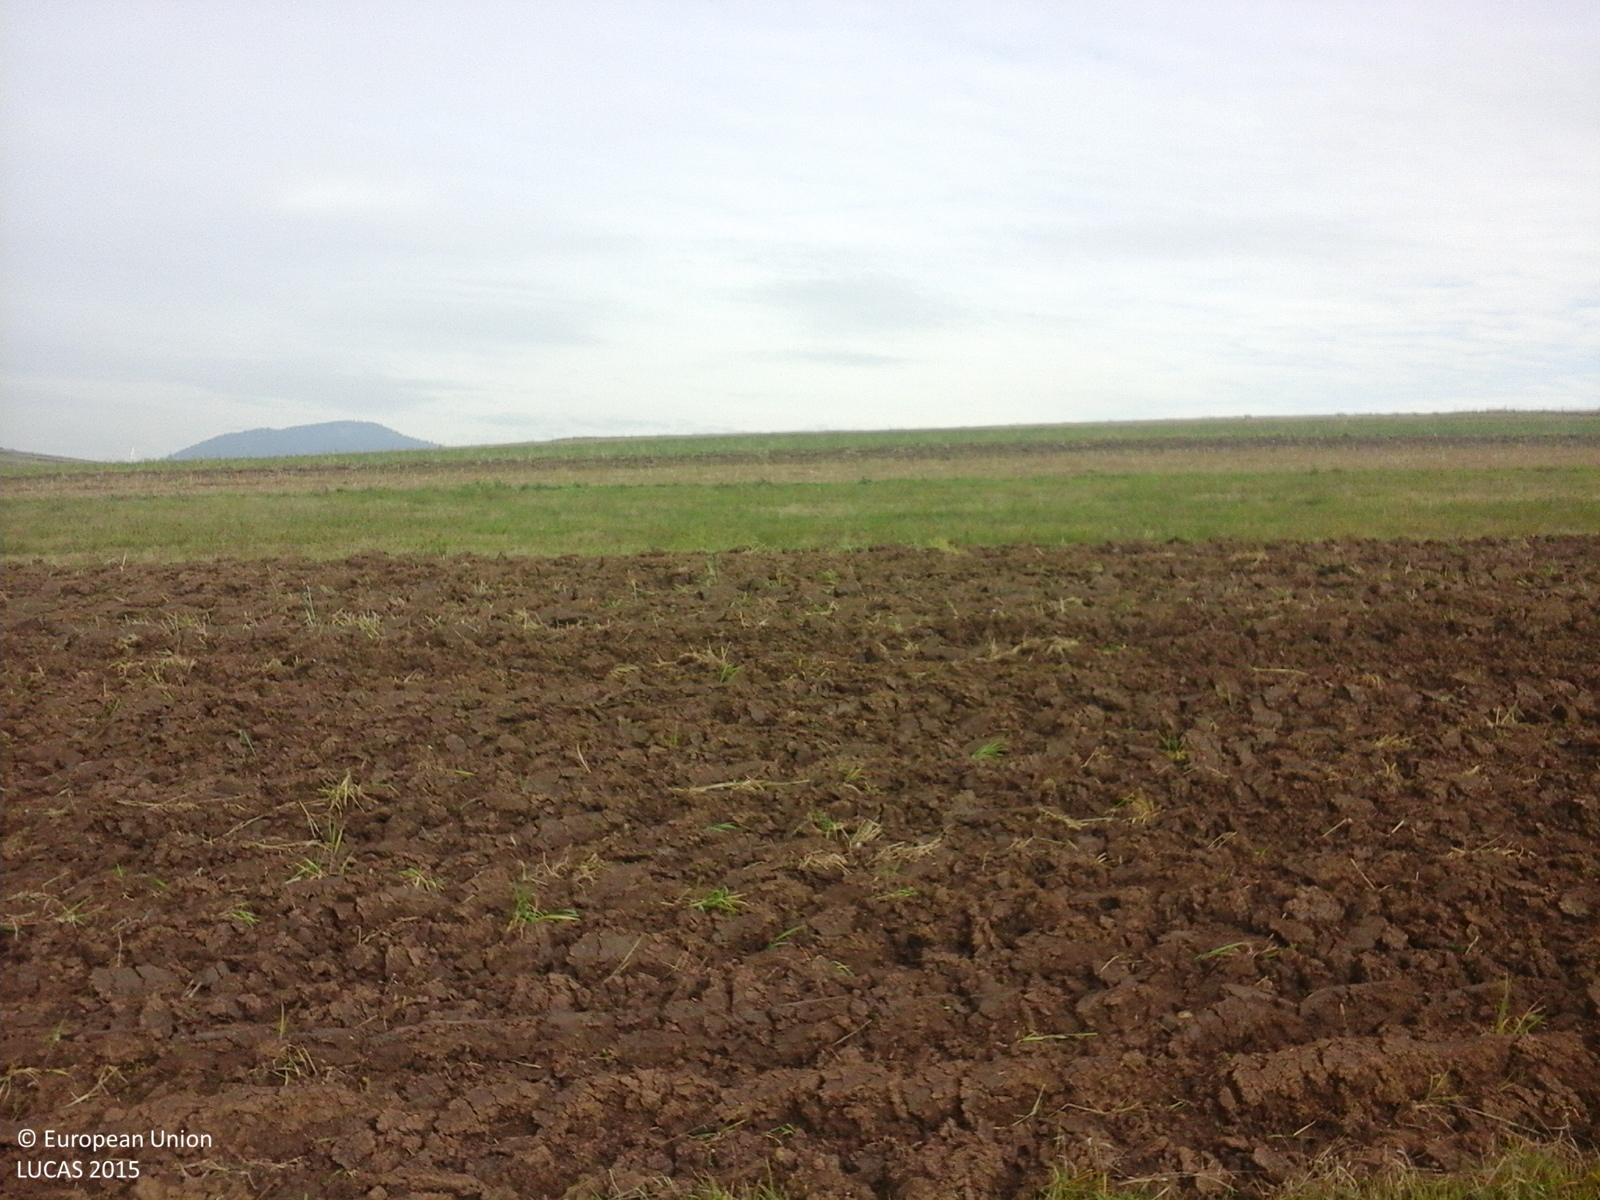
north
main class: Grassland
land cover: Grassland without tree/shrub cover
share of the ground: > 75 %
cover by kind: herbaceous plants 100 %
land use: Agriculture (excluding fallow land and kitchen gardens)
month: October
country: RO
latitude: 46.3165
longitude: 25.8425
